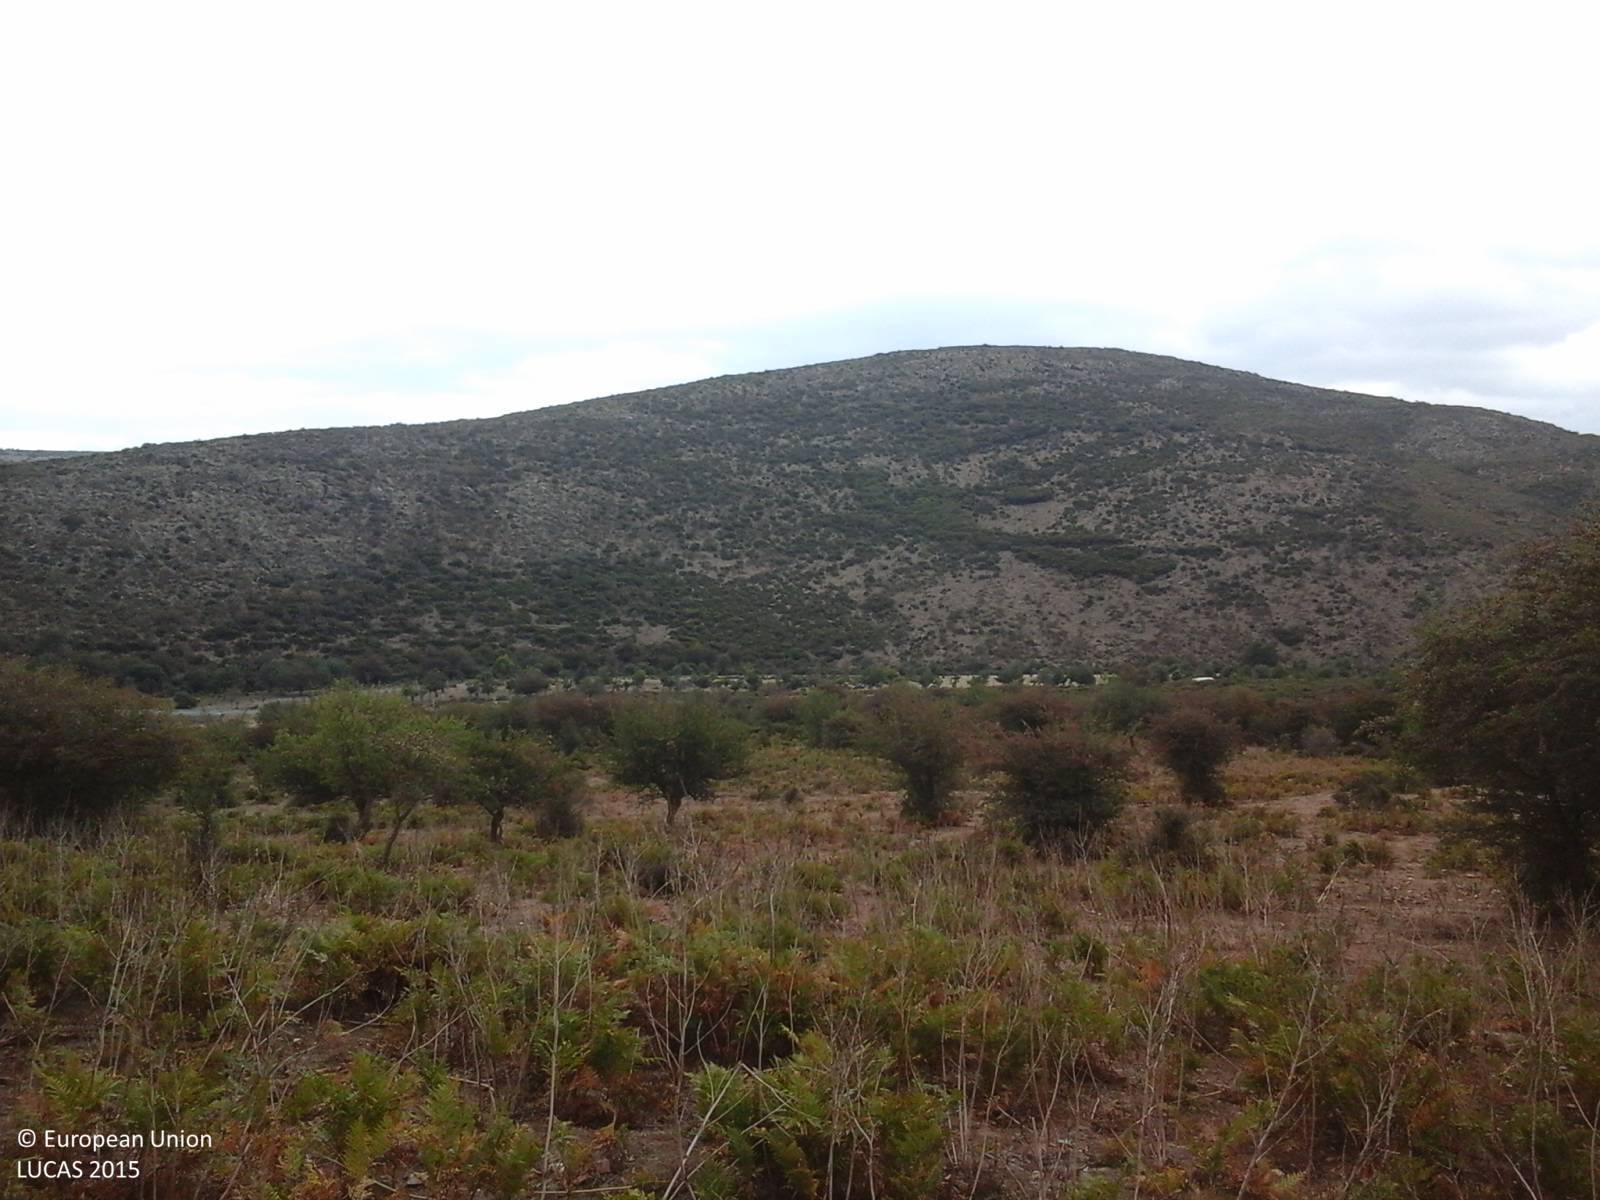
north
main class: Grassland
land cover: Grassland with sparse tree/shrub cover
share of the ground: > 75 %
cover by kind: herbaceous plants 90 %, broadleaved forest trees 5 %, shrubs 5 %
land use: Agriculture (excluding fallow land and kitchen gardens)
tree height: < 5 m
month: September
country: IT
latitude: 40.1385
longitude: 9.3579
